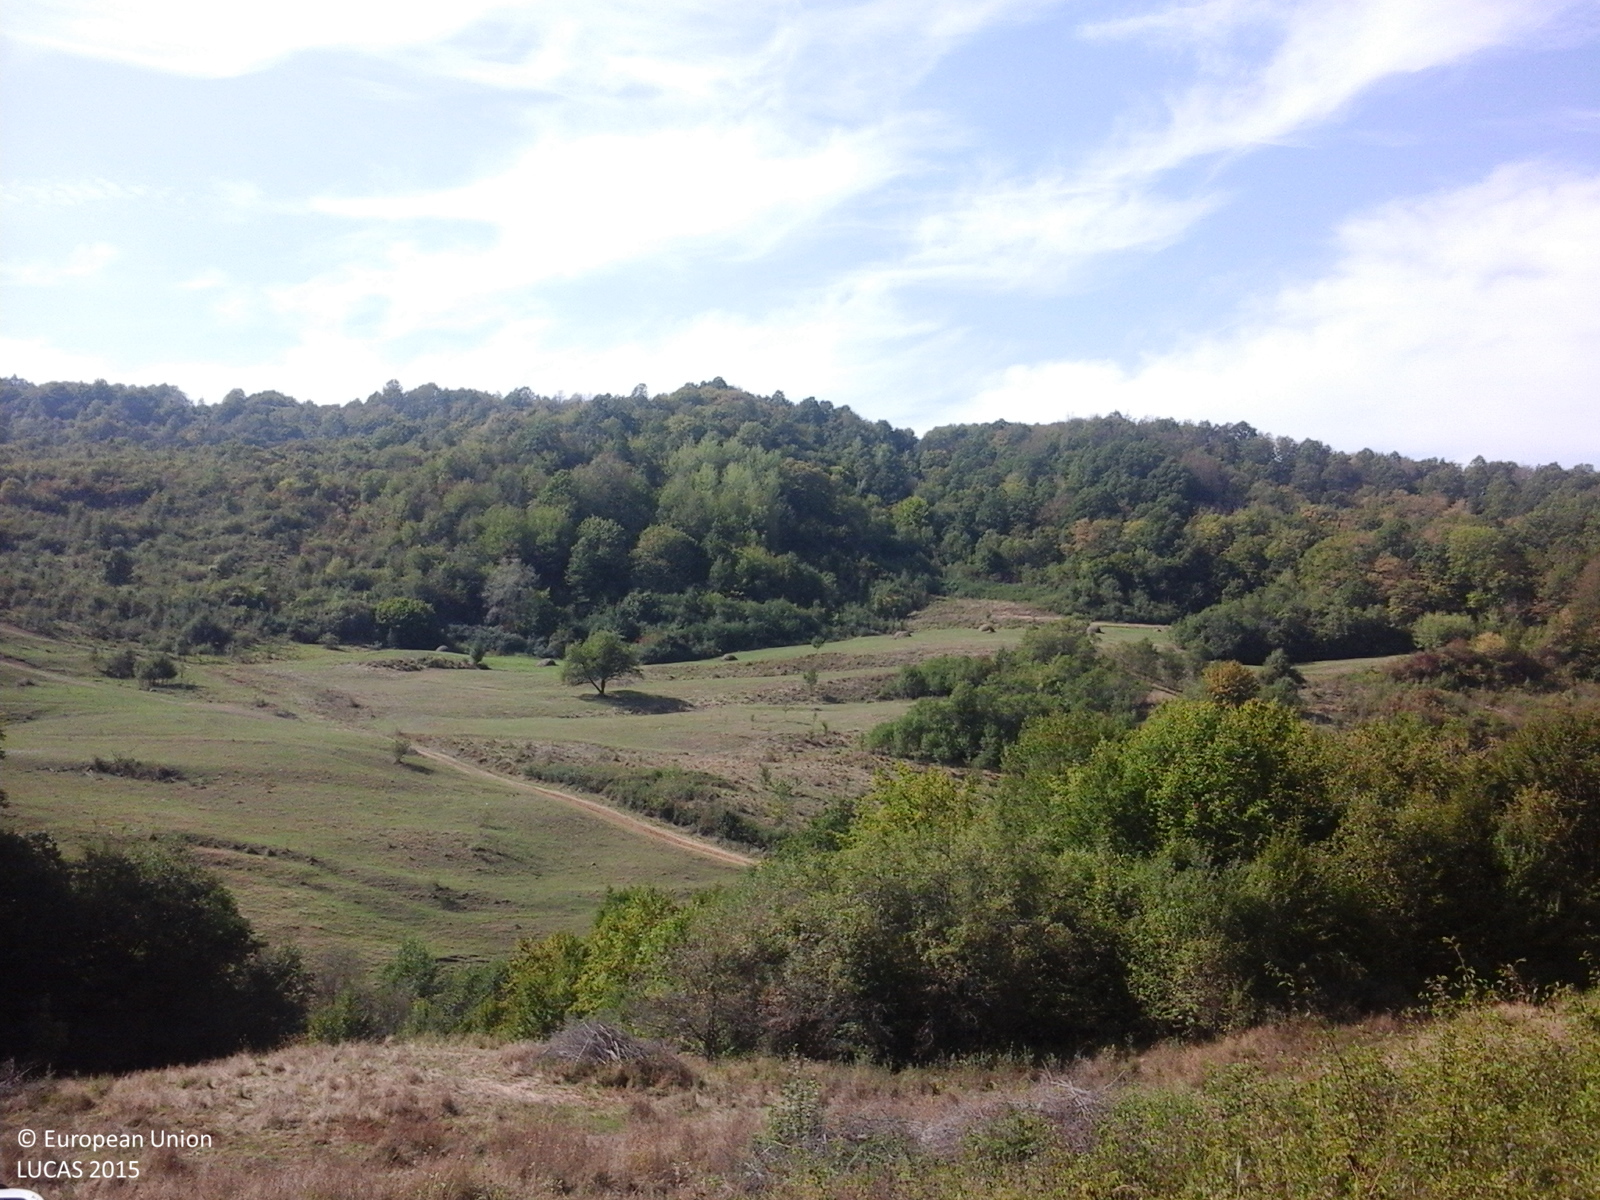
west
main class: Grassland
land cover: Spontaneously vegetated surfaces
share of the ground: > 75 %
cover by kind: herbaceous plants 100 %
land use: Fallow land
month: September
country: RO
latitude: 47.2394
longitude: 23.6686
